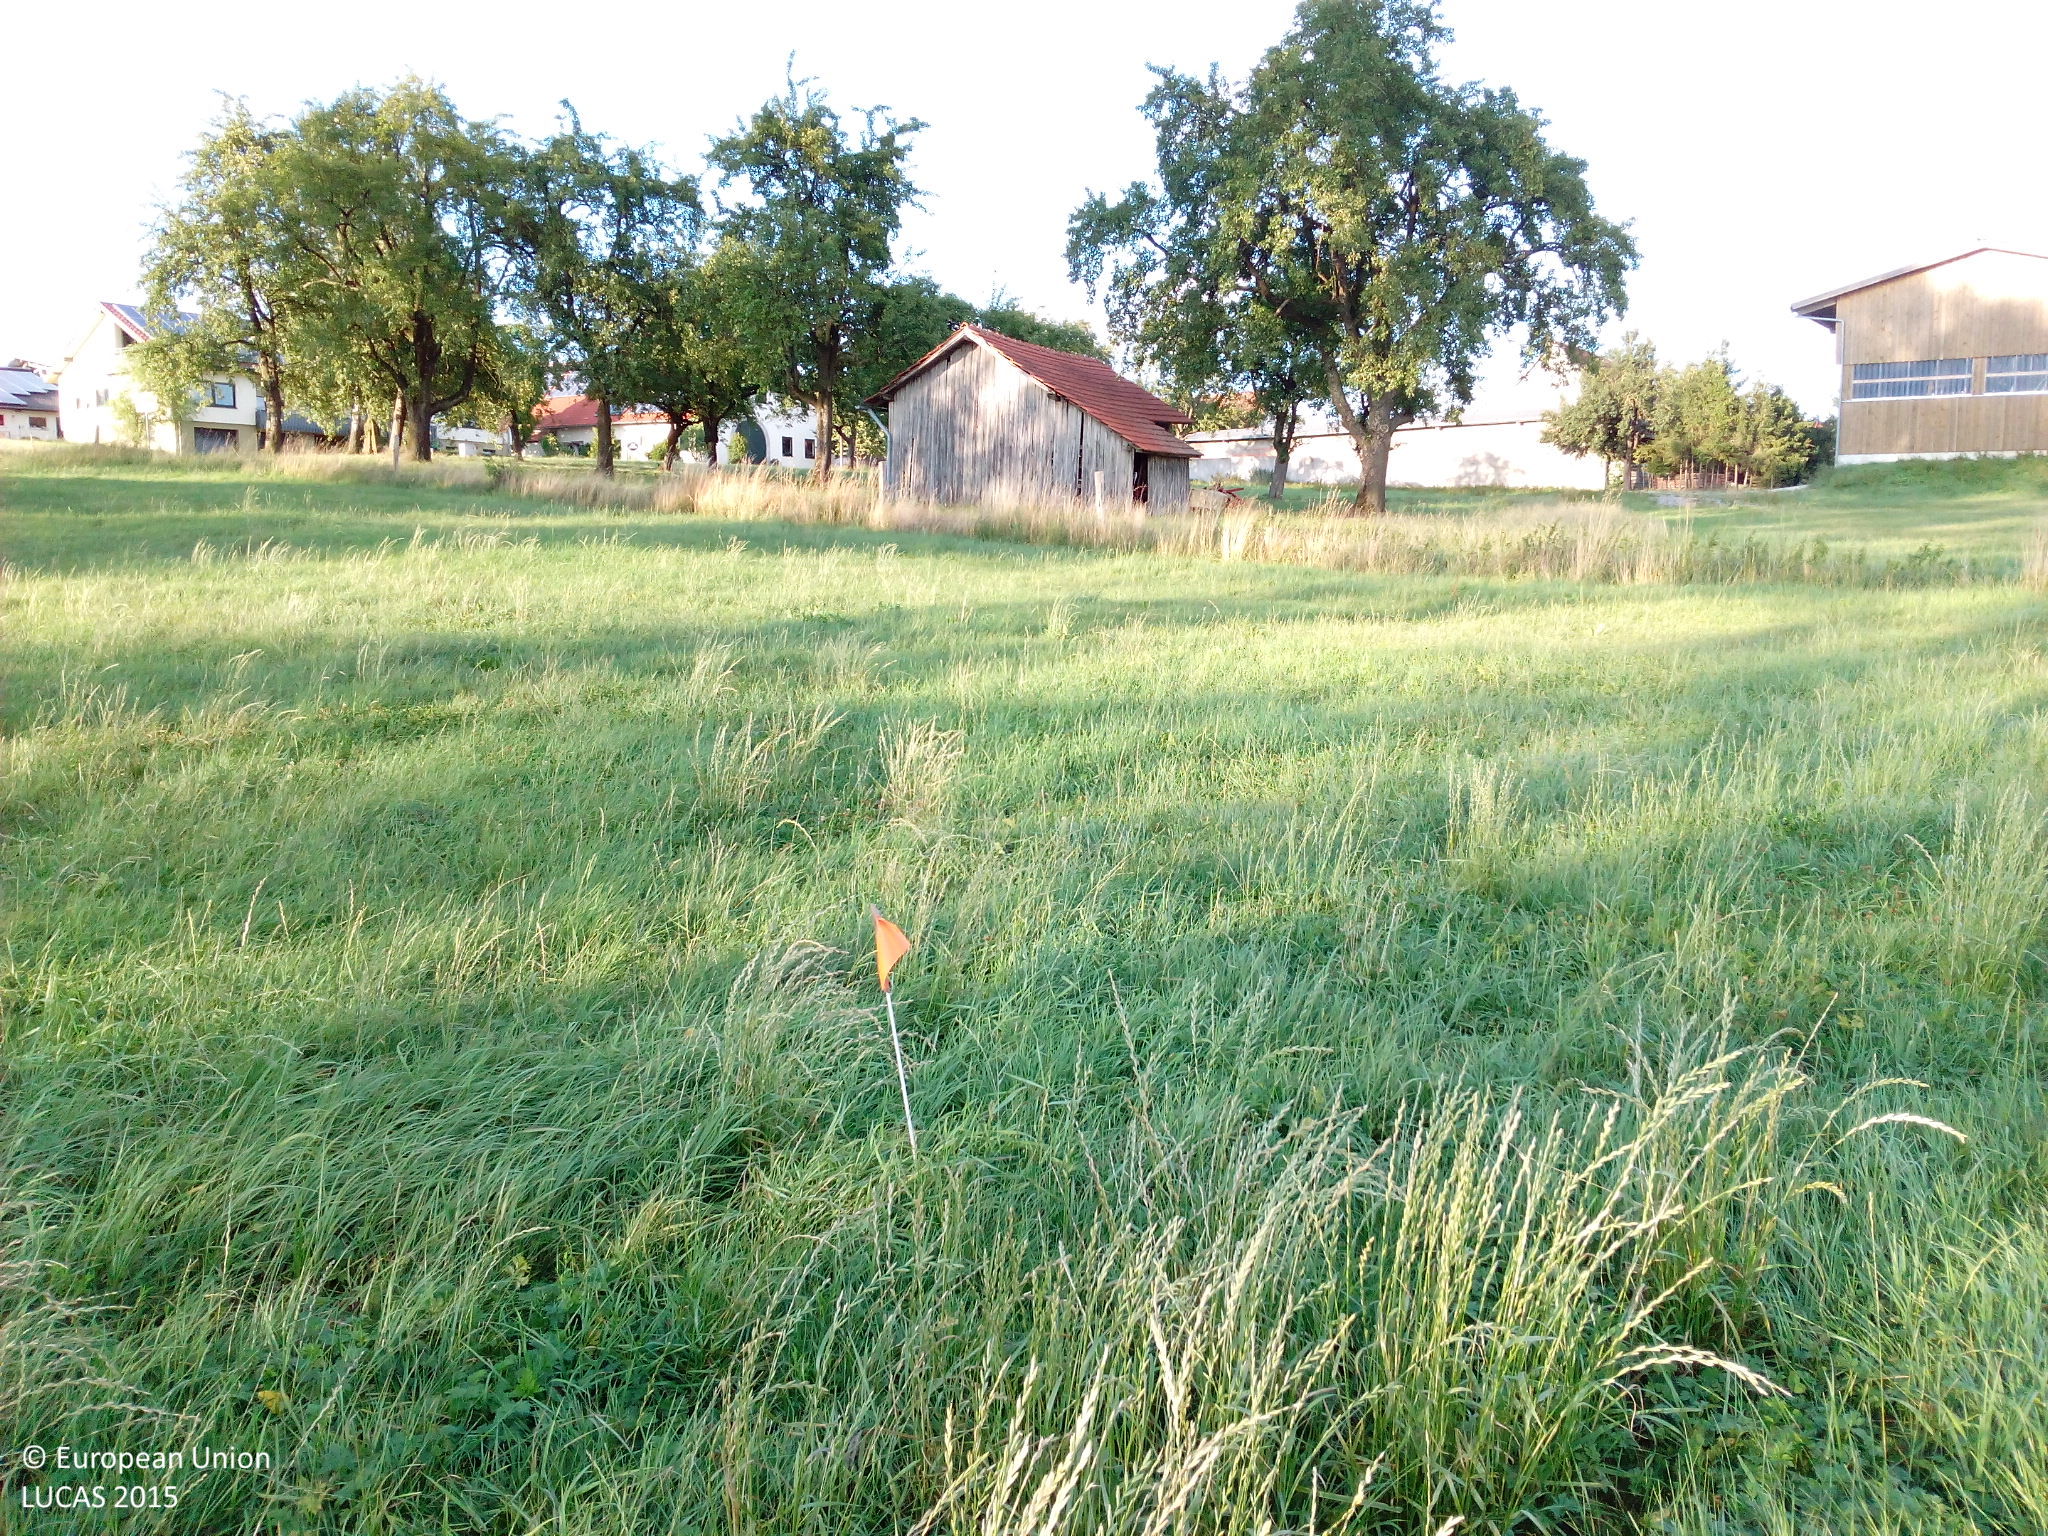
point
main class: Grassland
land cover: Grassland without tree/shrub cover
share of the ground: > 75 %
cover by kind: herbaceous plants 100 %
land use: Agriculture (excluding fallow land and kitchen gardens)
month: July
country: DE
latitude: 48.9429
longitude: 10.2593
